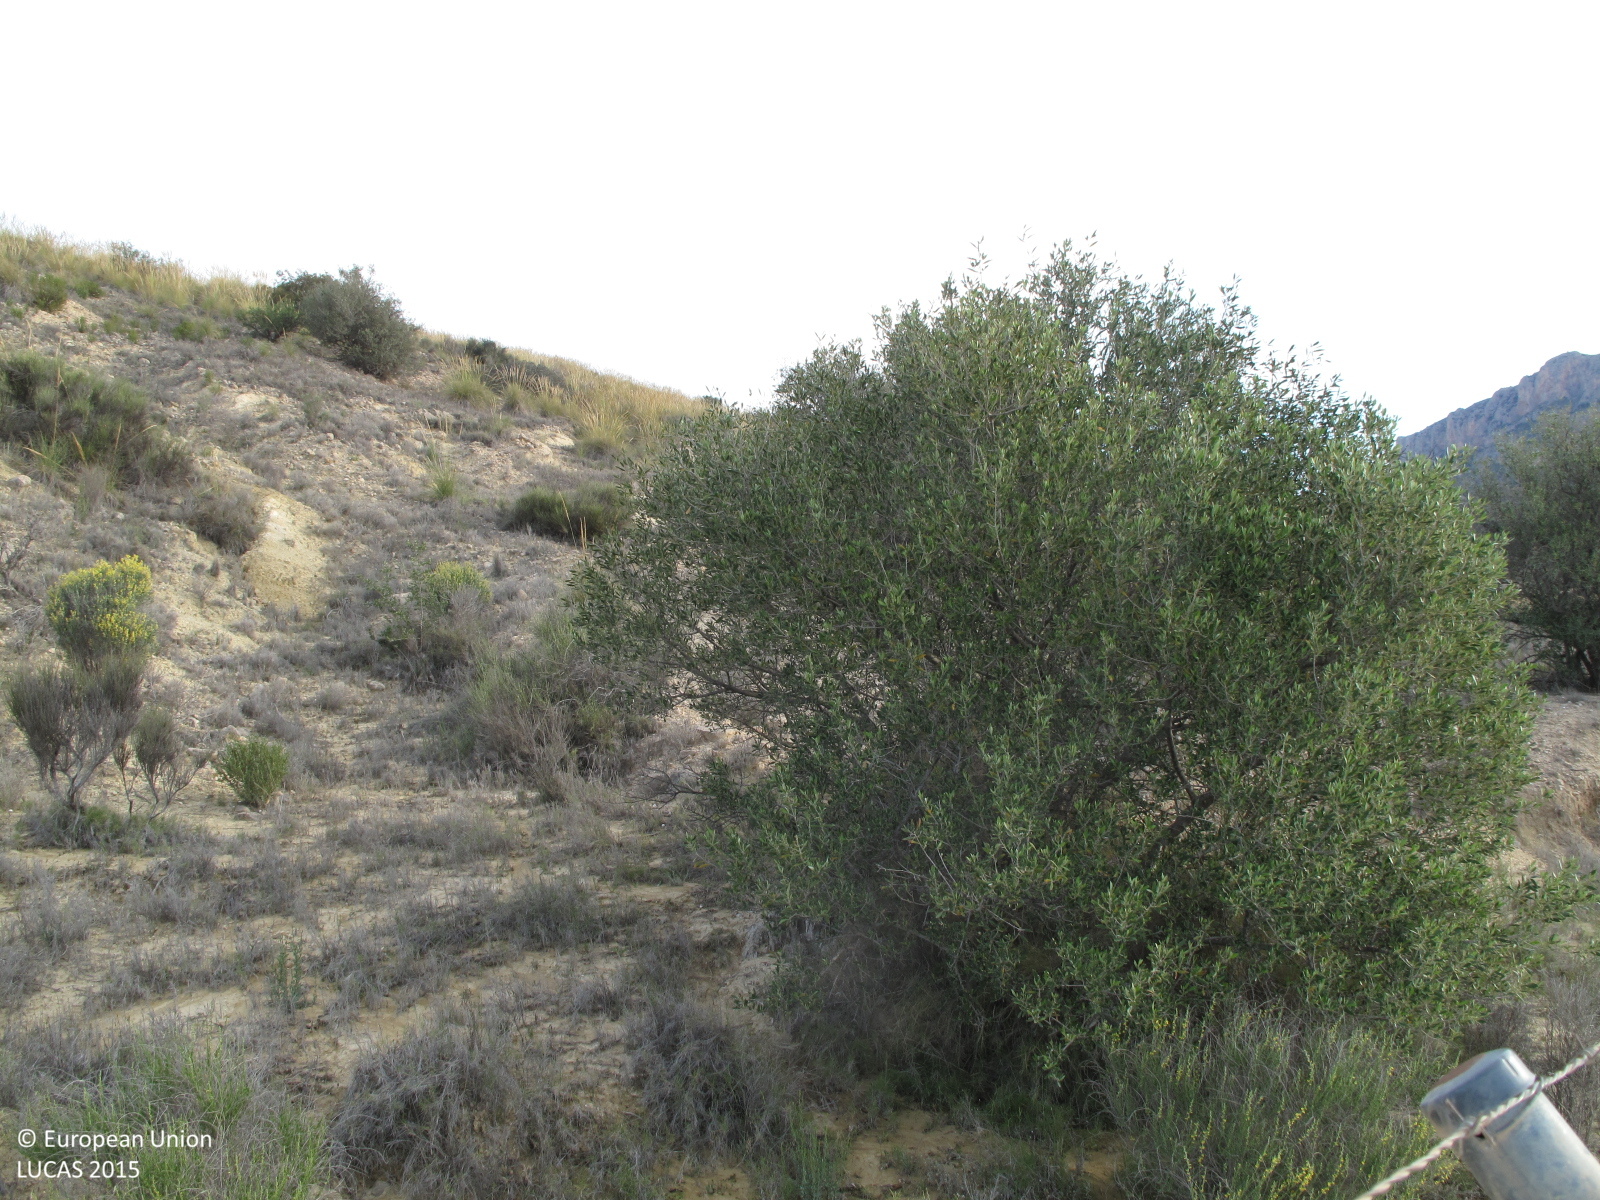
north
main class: Shrubland
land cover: Shrubland with sparse tree cover
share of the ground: 10 - 25 %
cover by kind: consolidated bare surface 60 %, herbaceous plants 20 %, shrubs 15 %, coniferous forest trees 5 %
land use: Abandoned areas
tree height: < 5 m
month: April
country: ES
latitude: 38.5054
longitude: -0.4337
